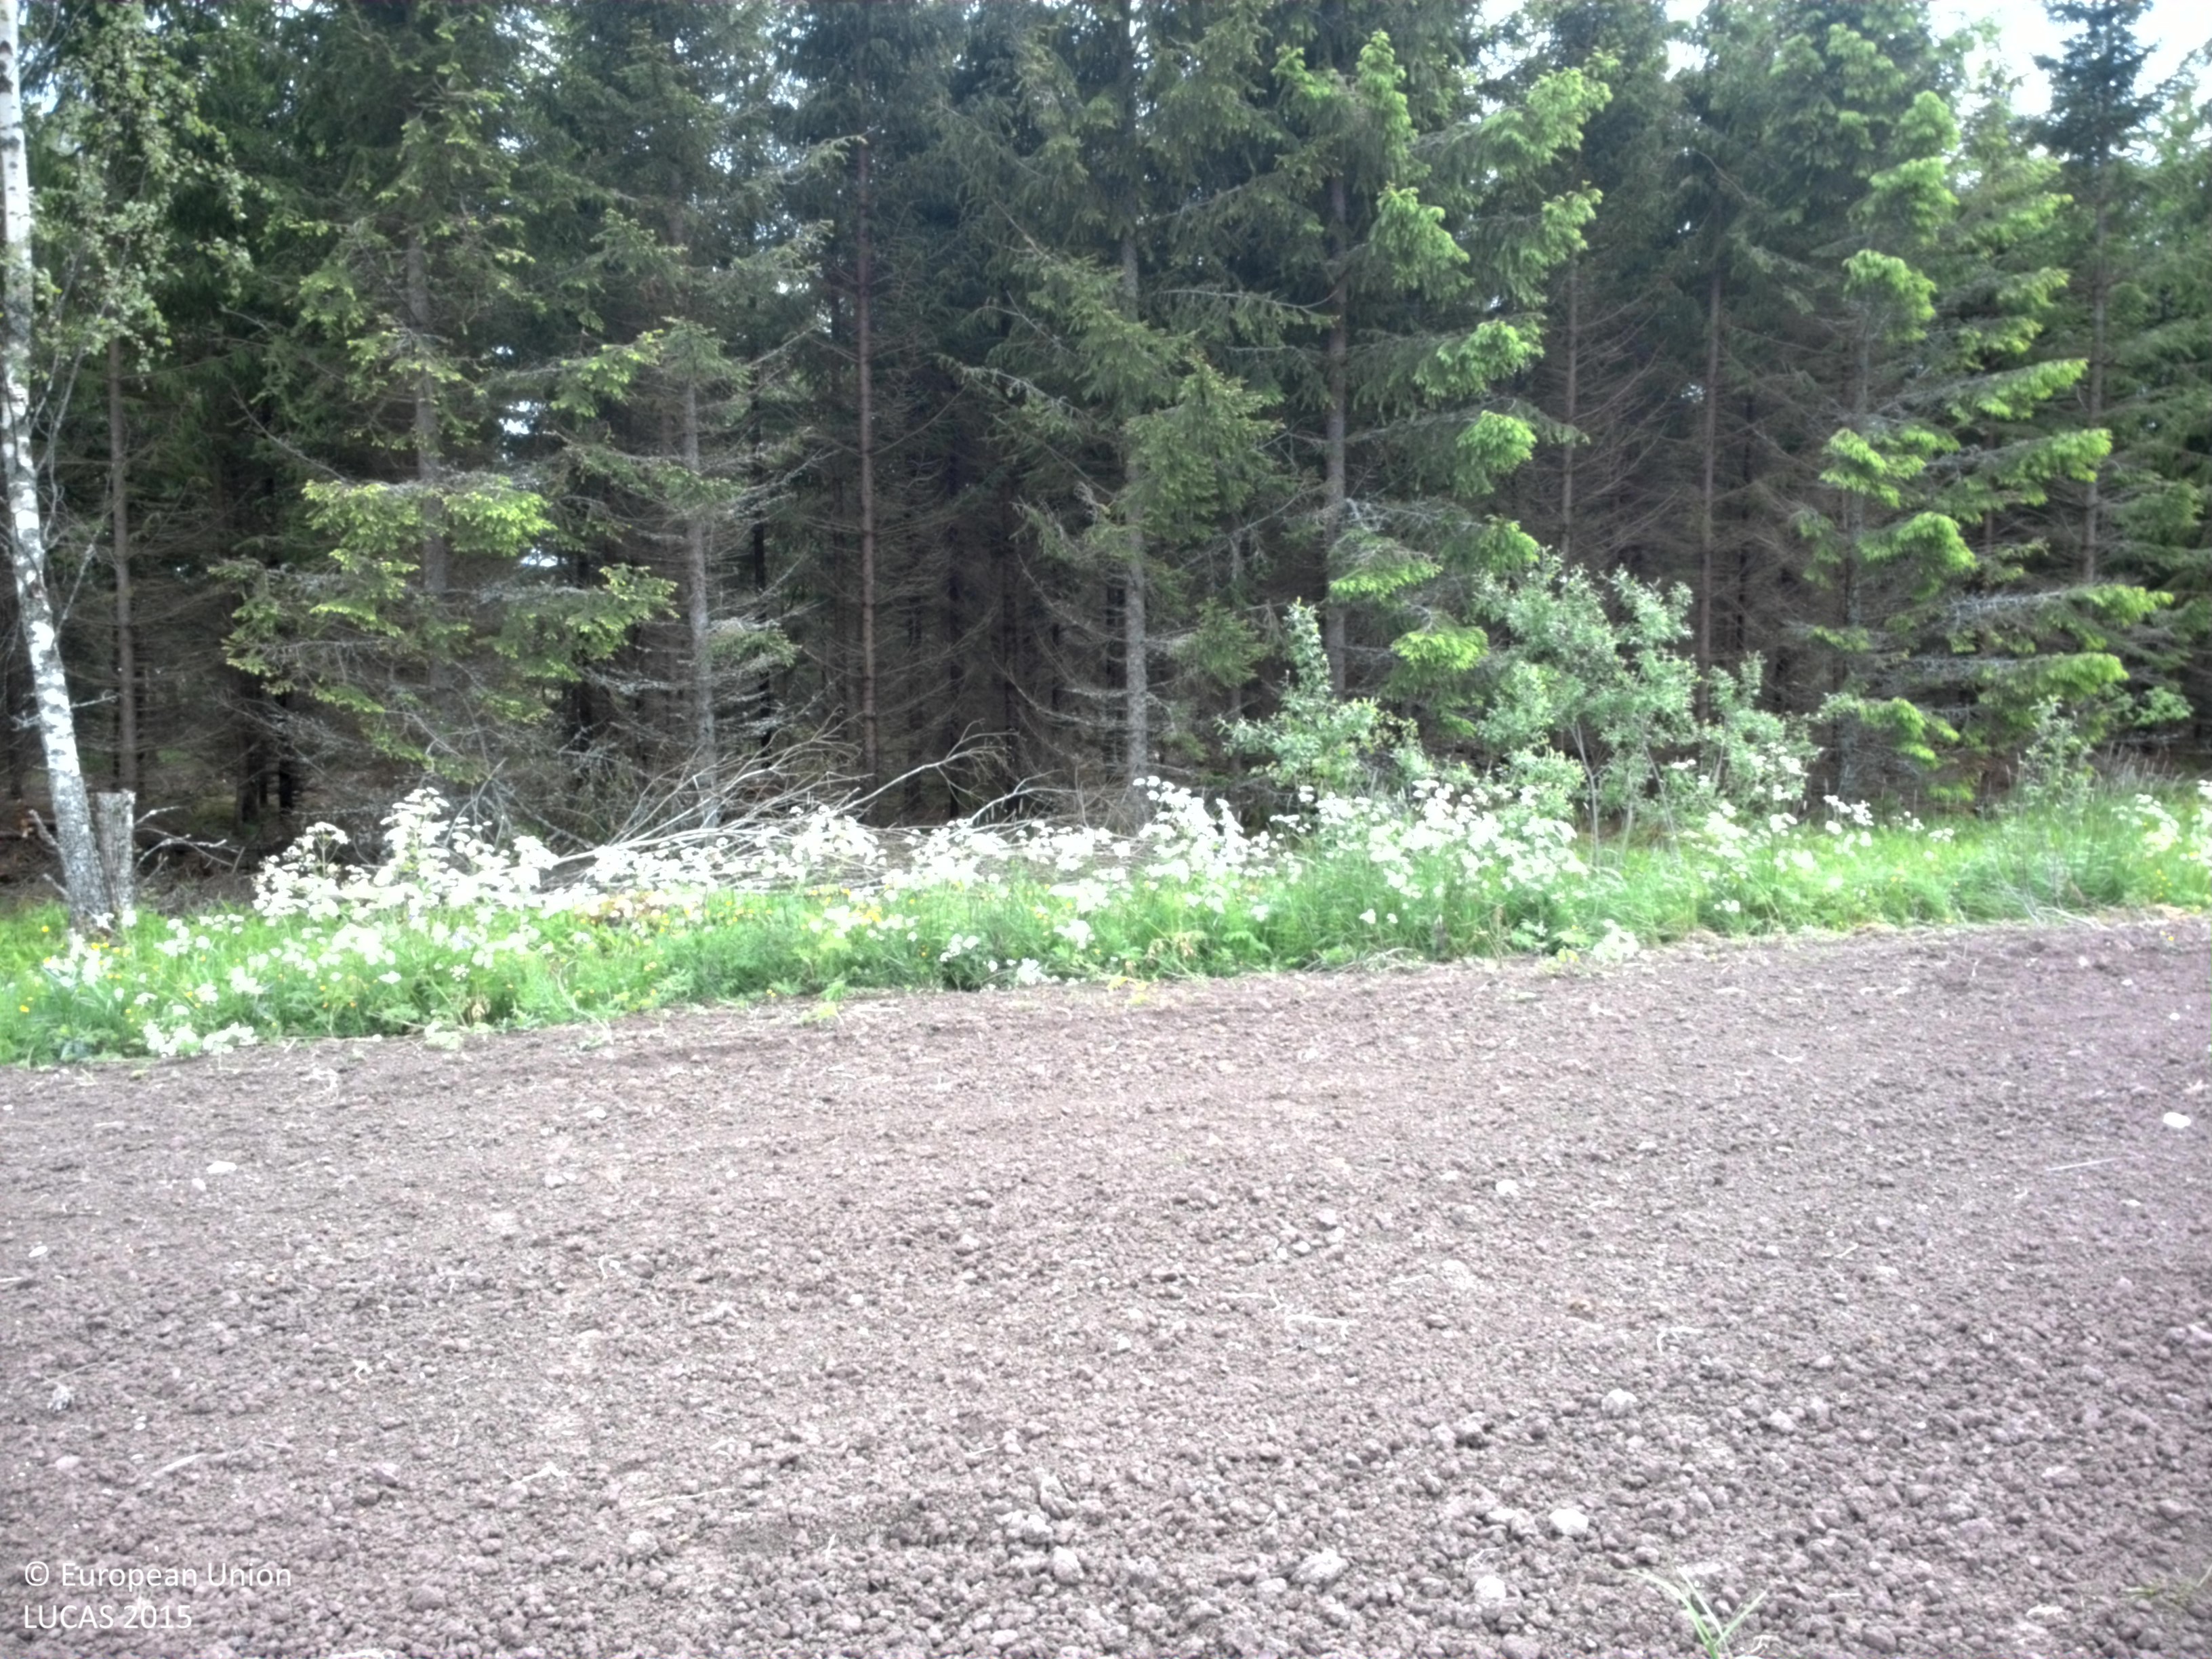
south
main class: Cropland
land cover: Oats
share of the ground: < 10 %
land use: Agriculture (excluding fallow land and kitchen gardens)
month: June
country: SE
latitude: 59.2638
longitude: 14.4297
